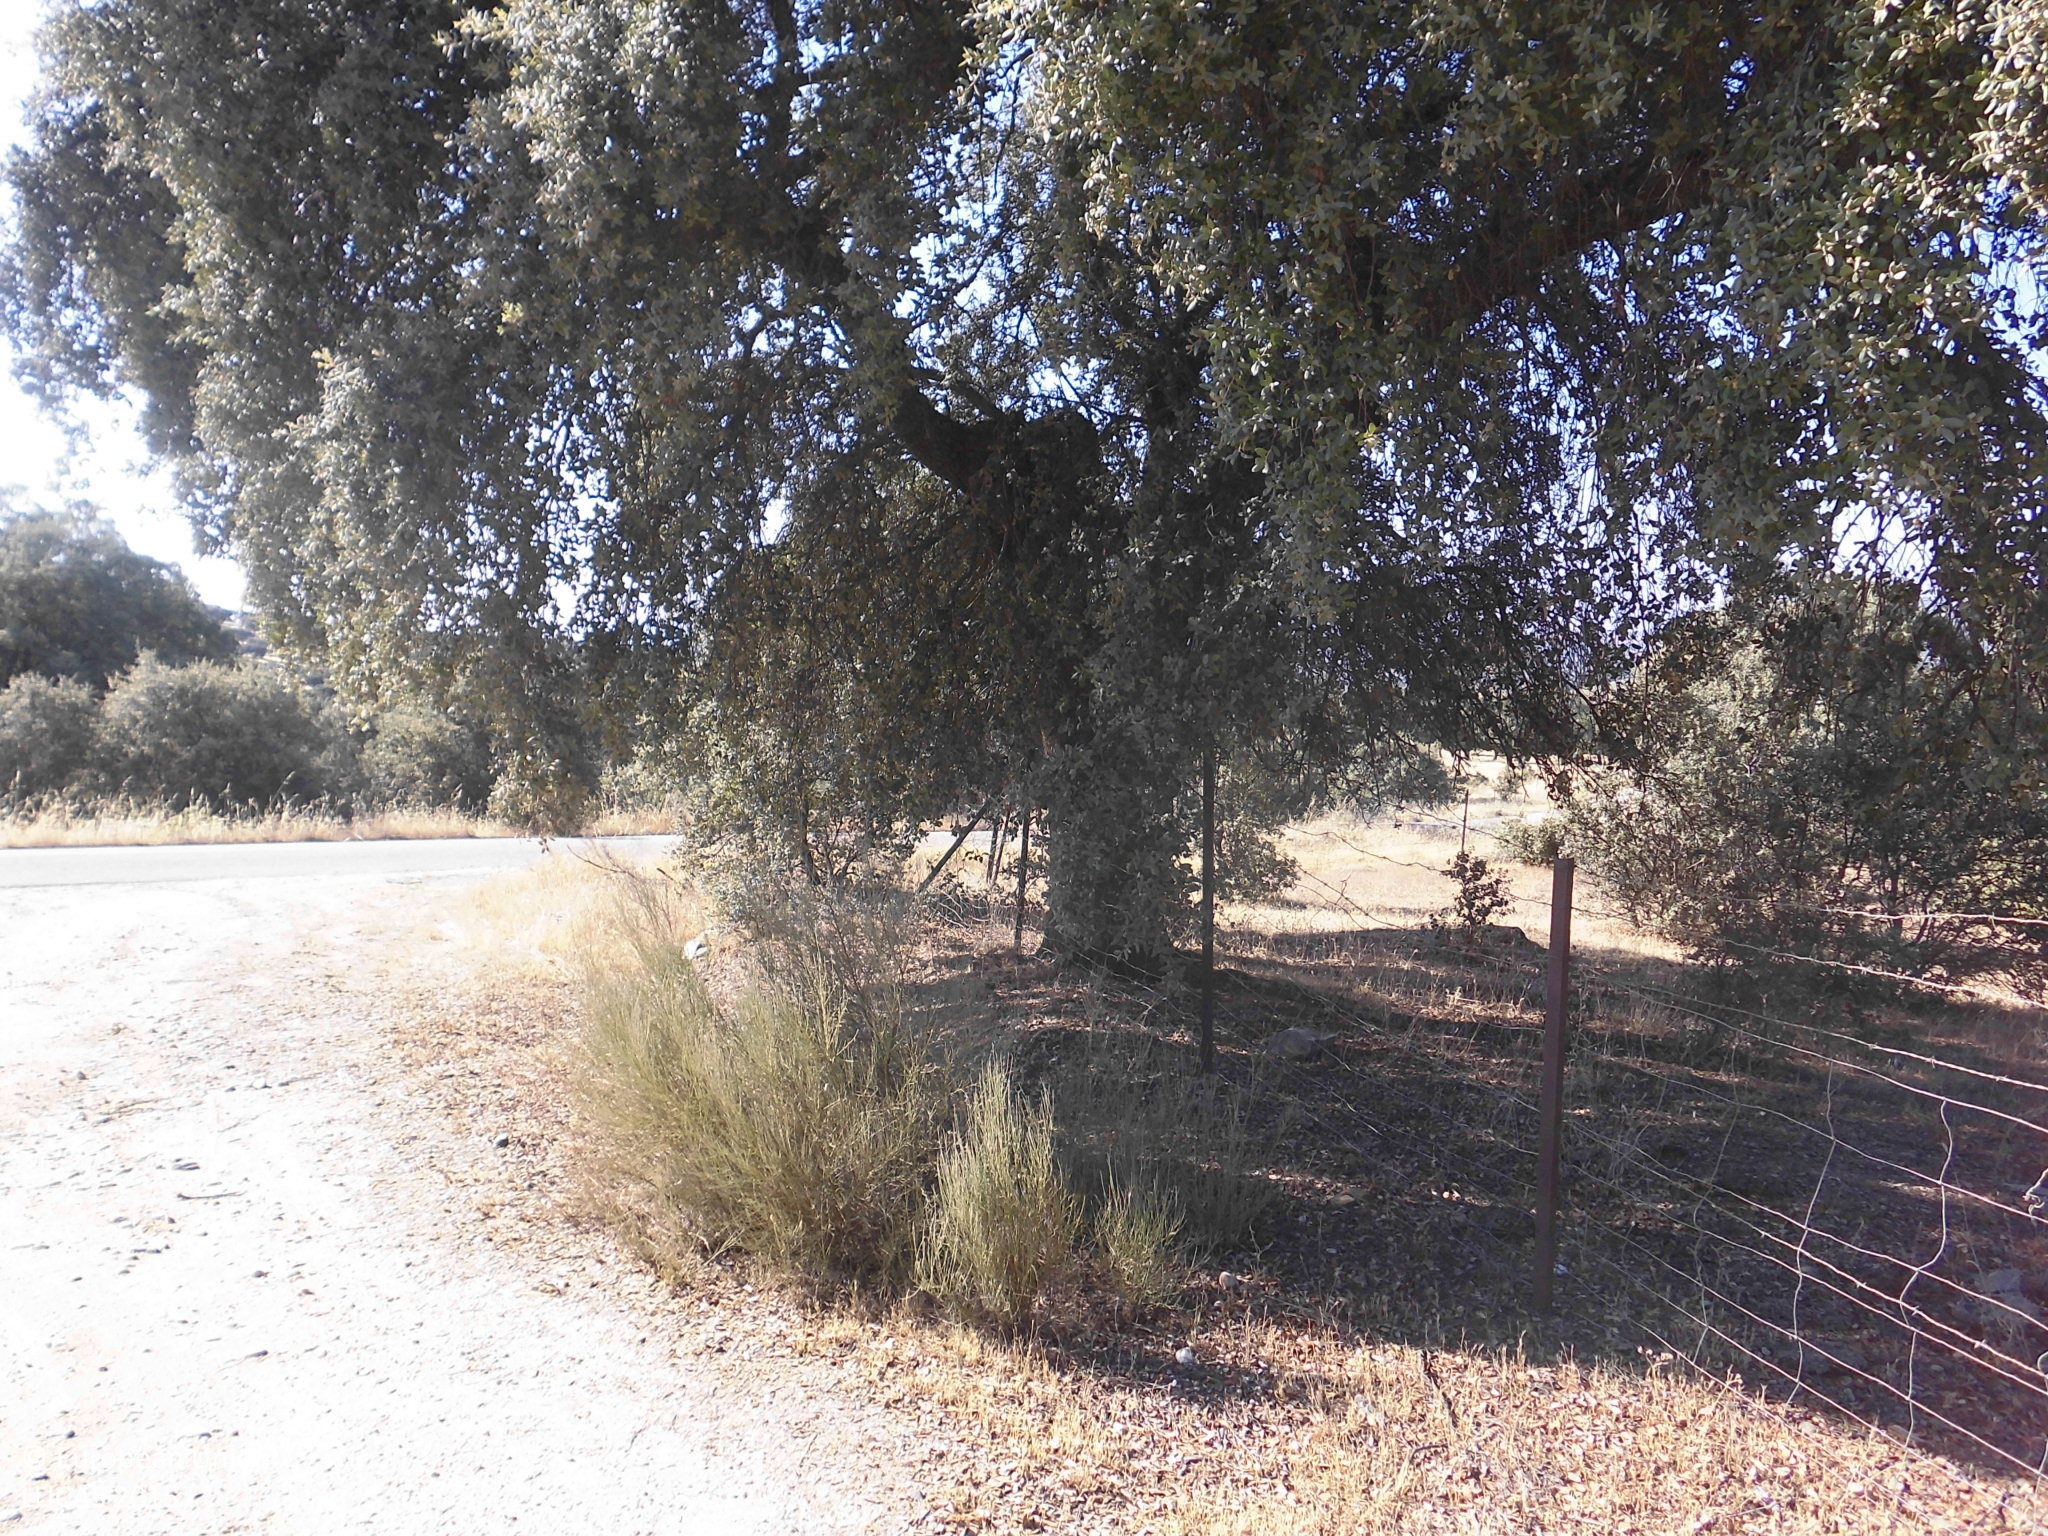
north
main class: Woodland
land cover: Broadleaved woodland
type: broadleaved evergreen forest
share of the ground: 50 - 75 %
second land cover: Grassland without tree/shrub cover
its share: > 75 %
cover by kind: broadleaved forest trees 60 %, herbaceous plants 40 %
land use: Forestry
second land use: Agriculture (excluding fallow land and kitchen gardens)
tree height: > 5 m
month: July
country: ES
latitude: 39.5282
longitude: -5.5848
